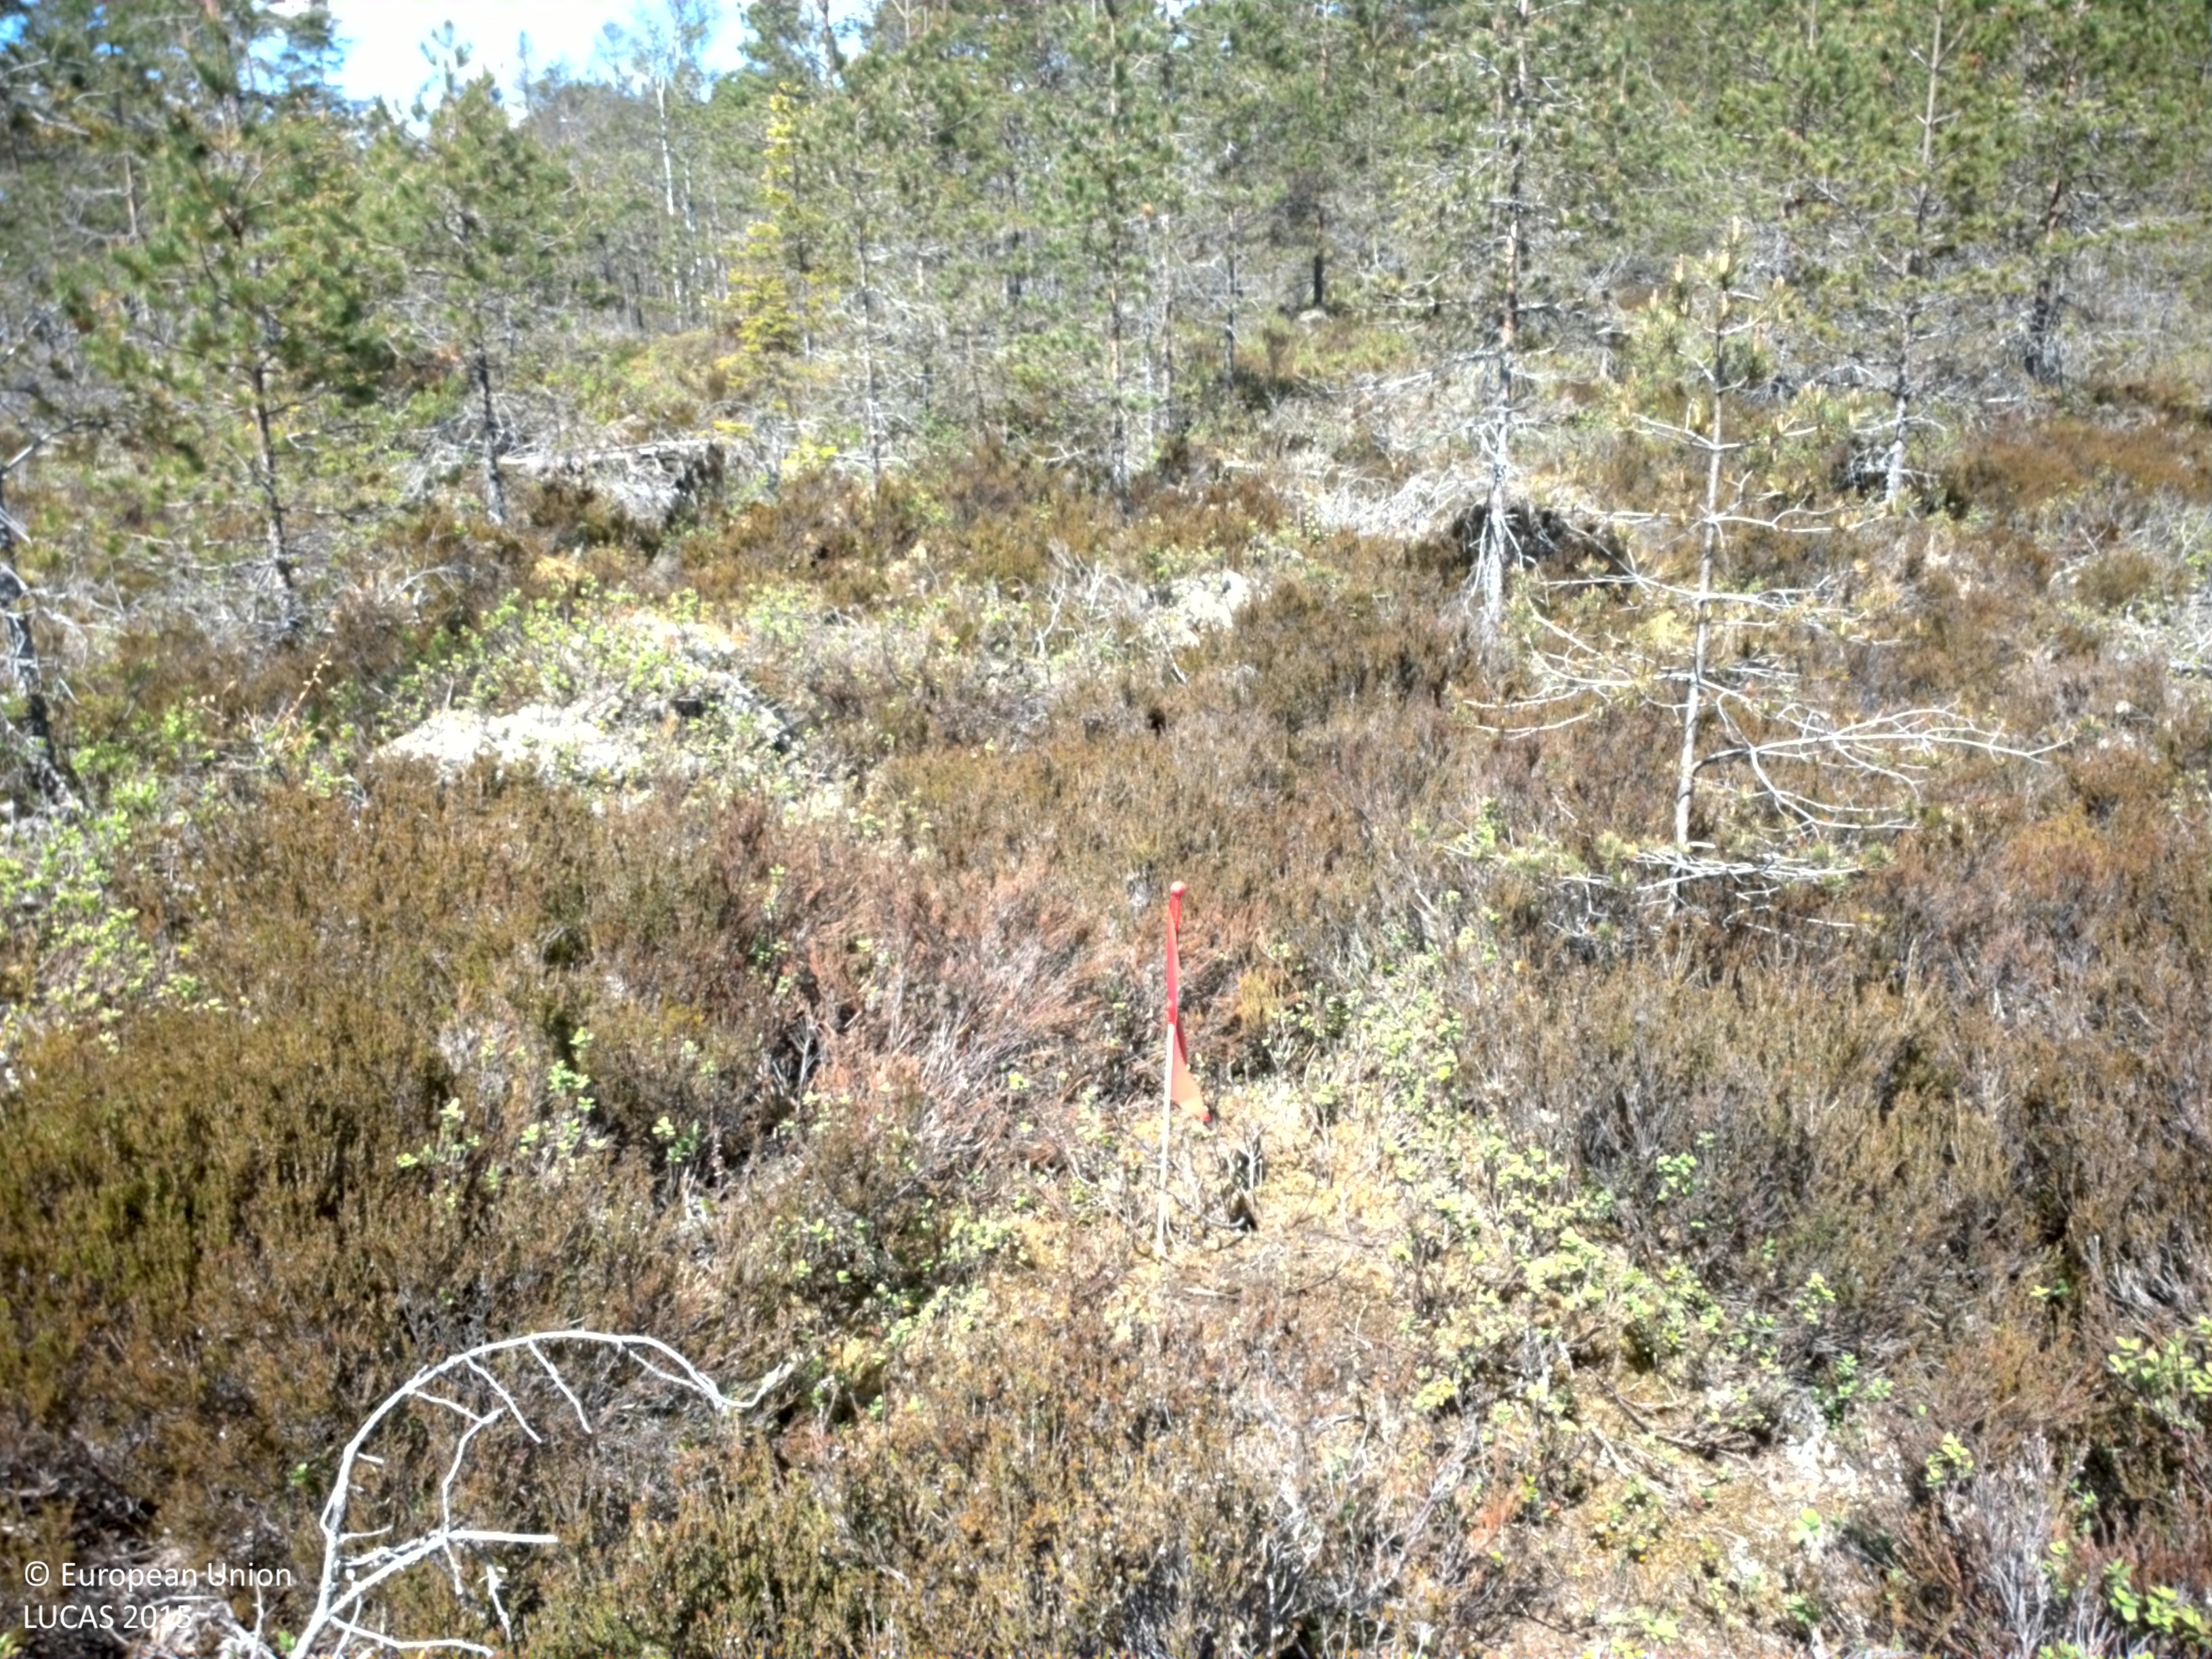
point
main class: Woodland
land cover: Pine dominated coniferous woodland
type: boreal forest
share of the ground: 50 - 75 %
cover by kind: coniferous forest trees 60 %, shrubs 25 %, lichens and mosses 15 %
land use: Forestry
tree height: < 5 m
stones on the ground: 10 - 25 %
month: June
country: SE
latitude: 59.4224
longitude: 12.3732
